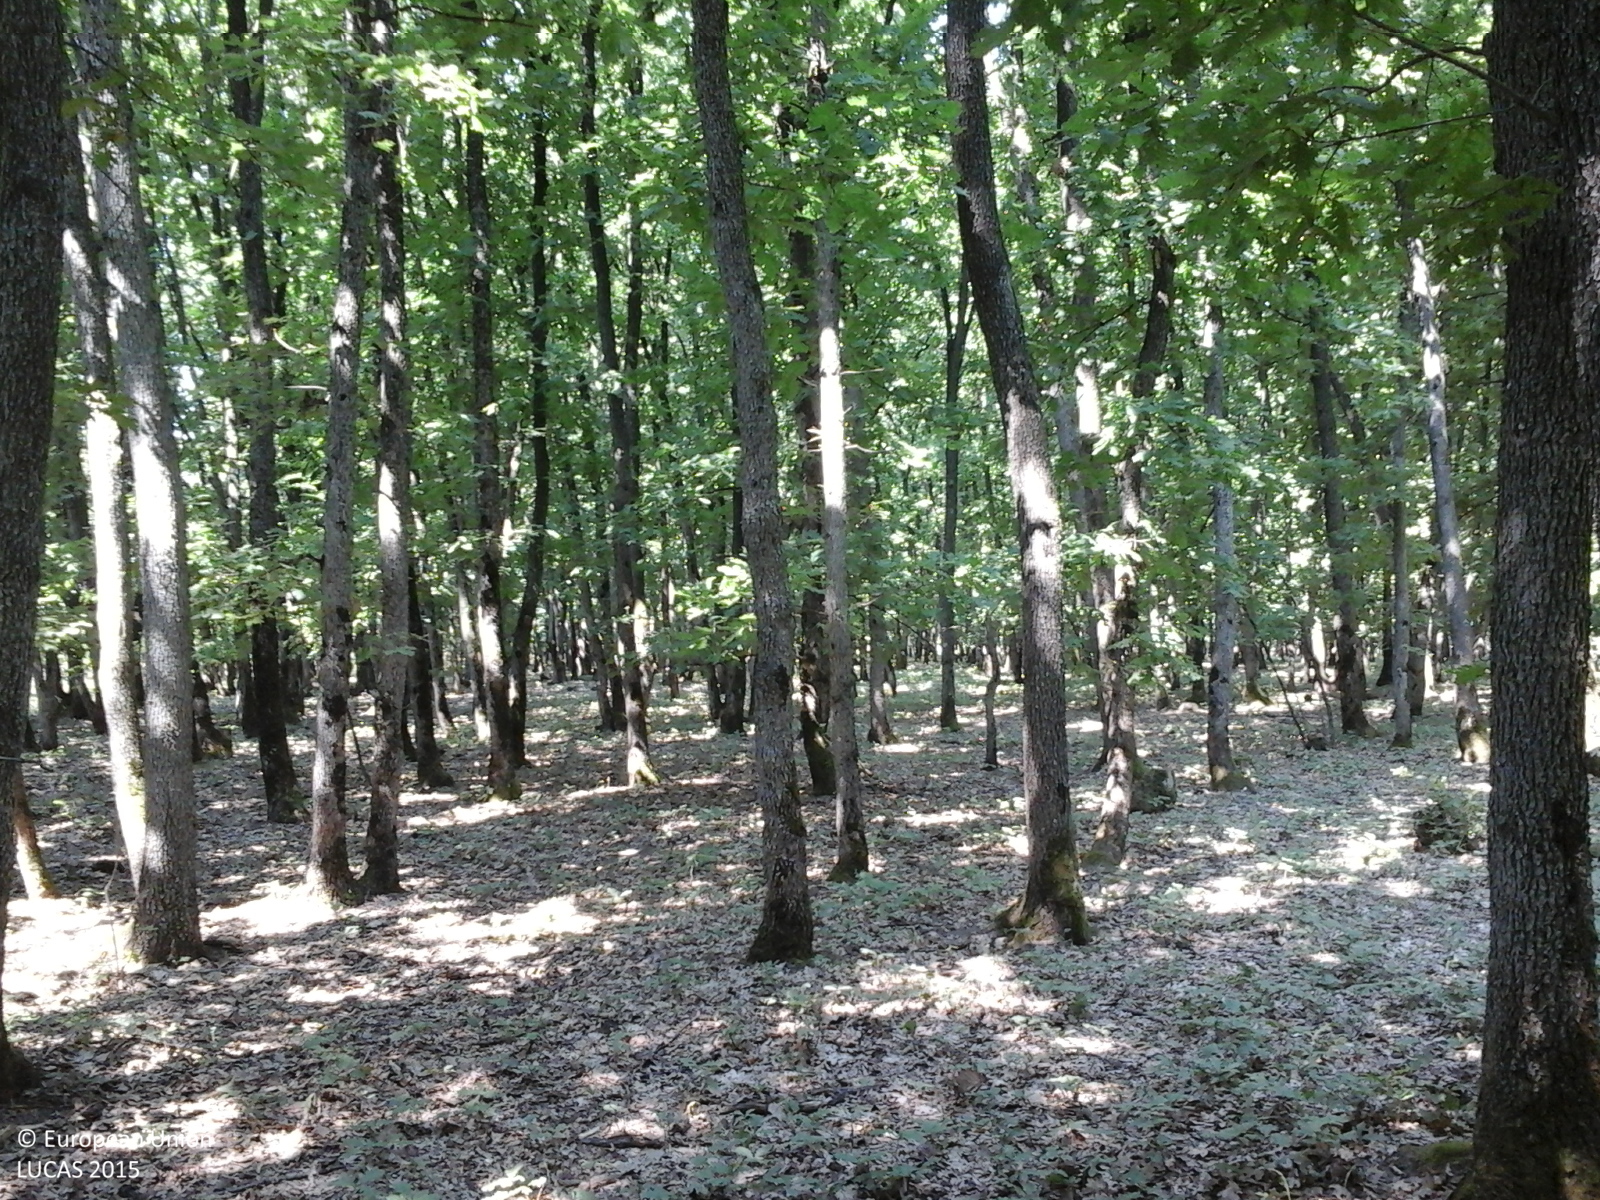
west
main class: Woodland
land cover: Broadleaved woodland
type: acidophilous oak and oak-birch forest
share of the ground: > 75 %
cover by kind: broadleaved forest trees 100 %
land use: Forestry
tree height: > 5 m
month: July
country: RO
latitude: 44.6423
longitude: 24.6369
